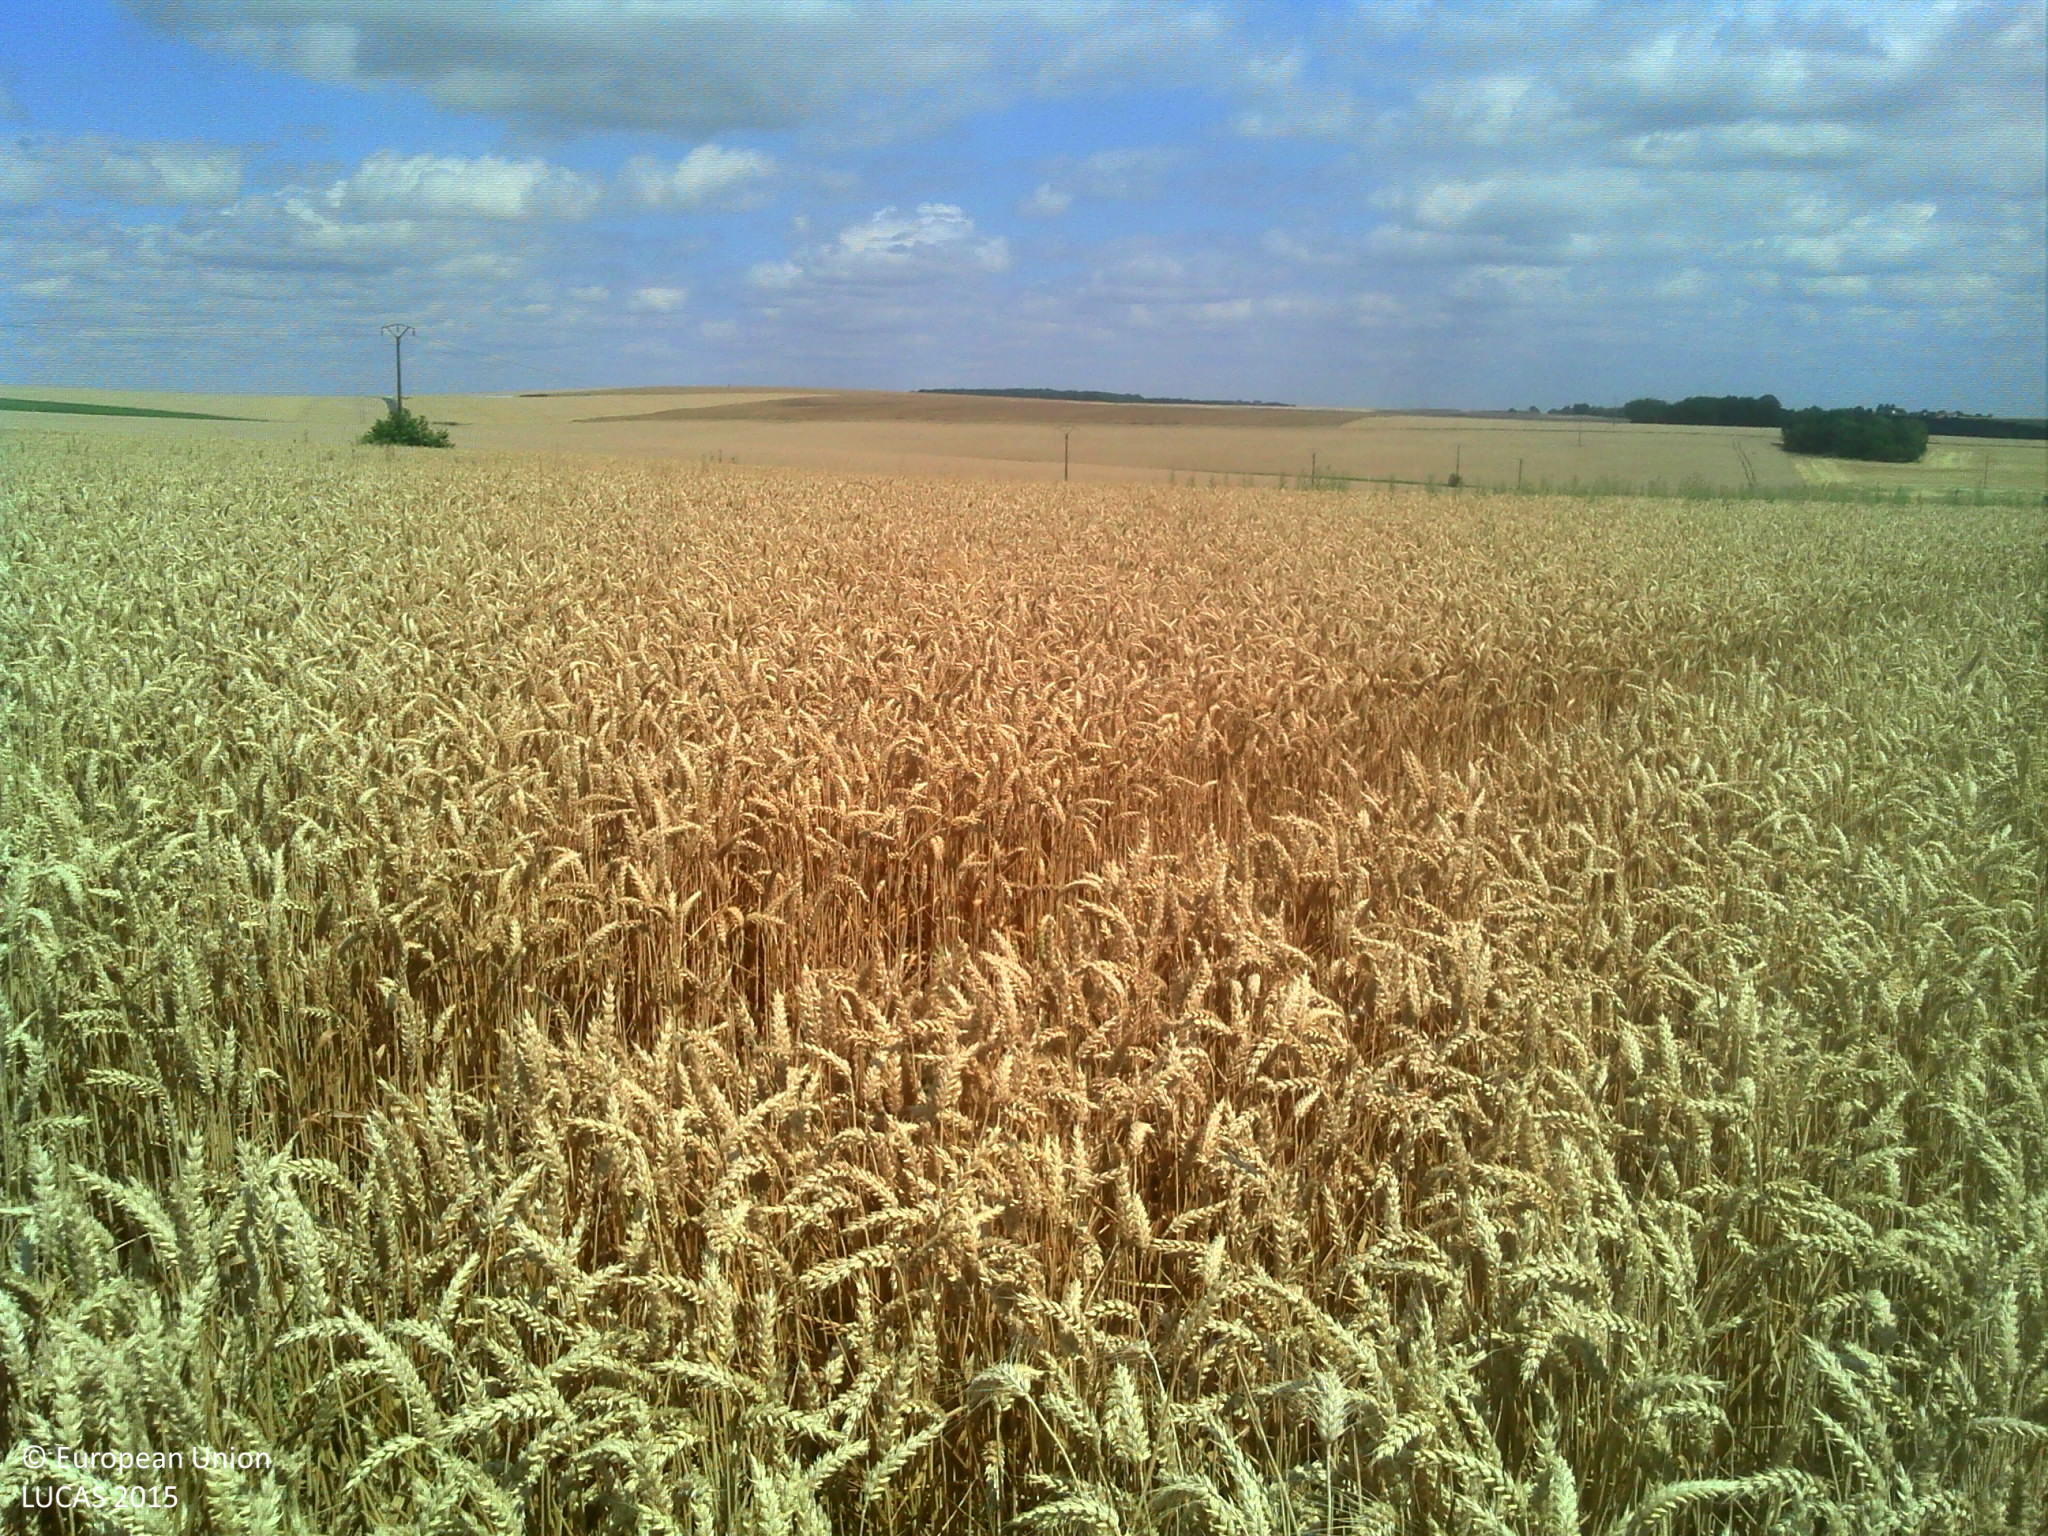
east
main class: Cropland
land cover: Common wheat
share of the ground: > 75 %
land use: Agriculture (excluding fallow land and kitchen gardens)
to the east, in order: Common wheat; Grass margins; Ditches and canals; Grass margins; Paved roads, cycling and walking lanes; Grass margins; Ditches and canals; Grass margins; Common wheat
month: July
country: FR
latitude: 49.2473
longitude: 3.3022
